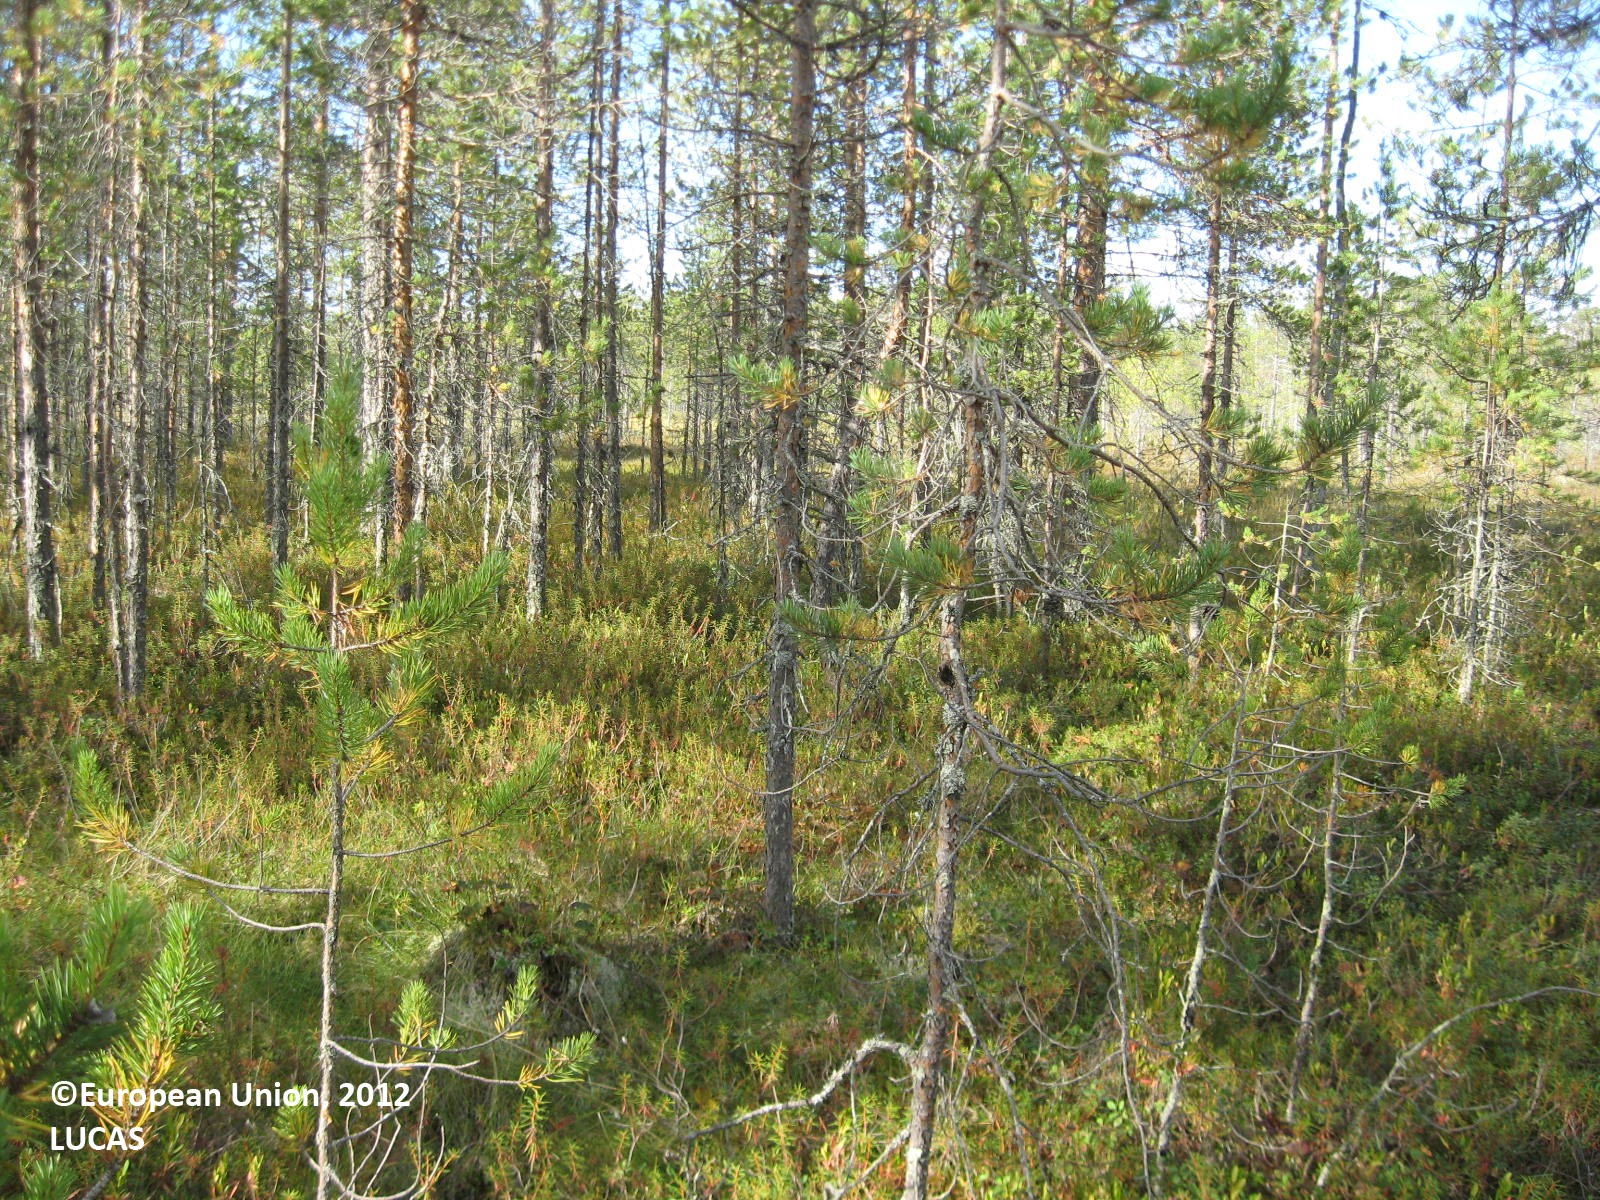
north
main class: Woodland
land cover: Pine dominated coniferous woodland
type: boreal forest
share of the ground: 50 - 75 %
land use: Semi-natural and natural areas not in use
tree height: > 5 m
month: August
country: FI
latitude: 63.8402
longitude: 29.2201
